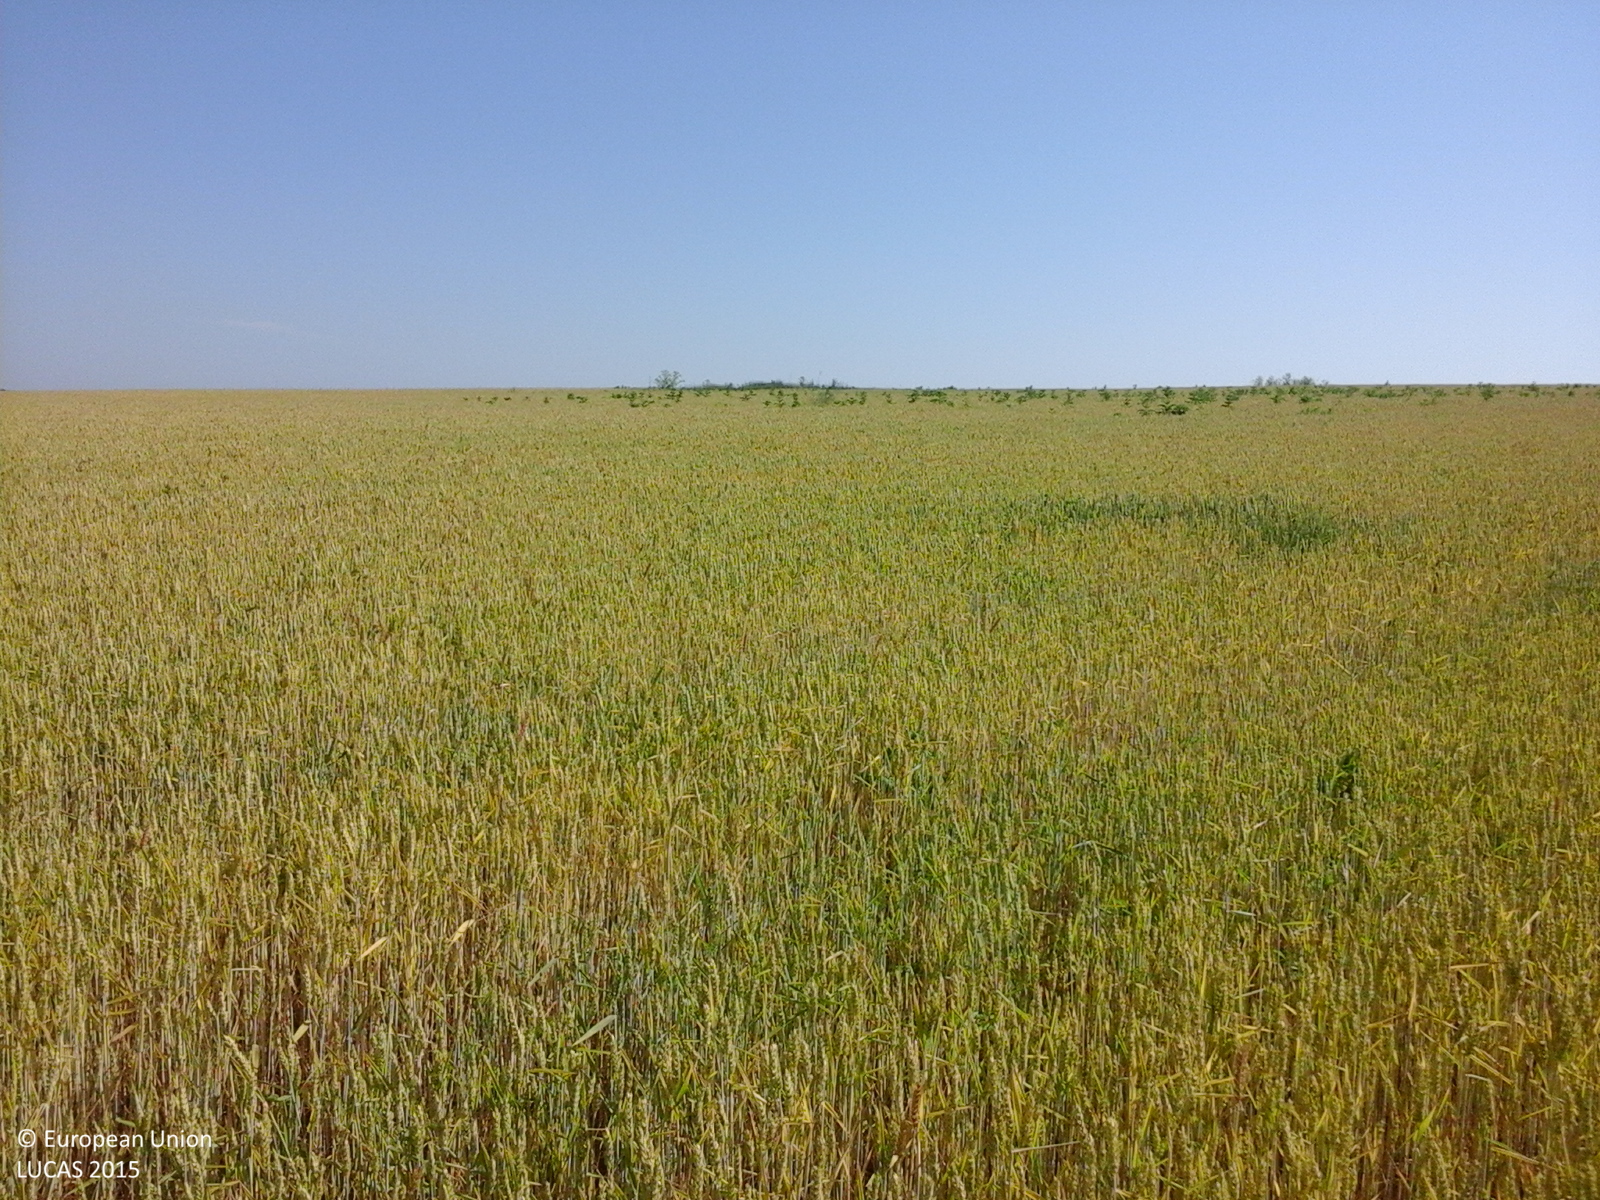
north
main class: Cropland
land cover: Common wheat
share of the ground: > 75 %
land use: Agriculture (excluding fallow land and kitchen gardens)
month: June
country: RO
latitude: 47.6804
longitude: 27.1185
